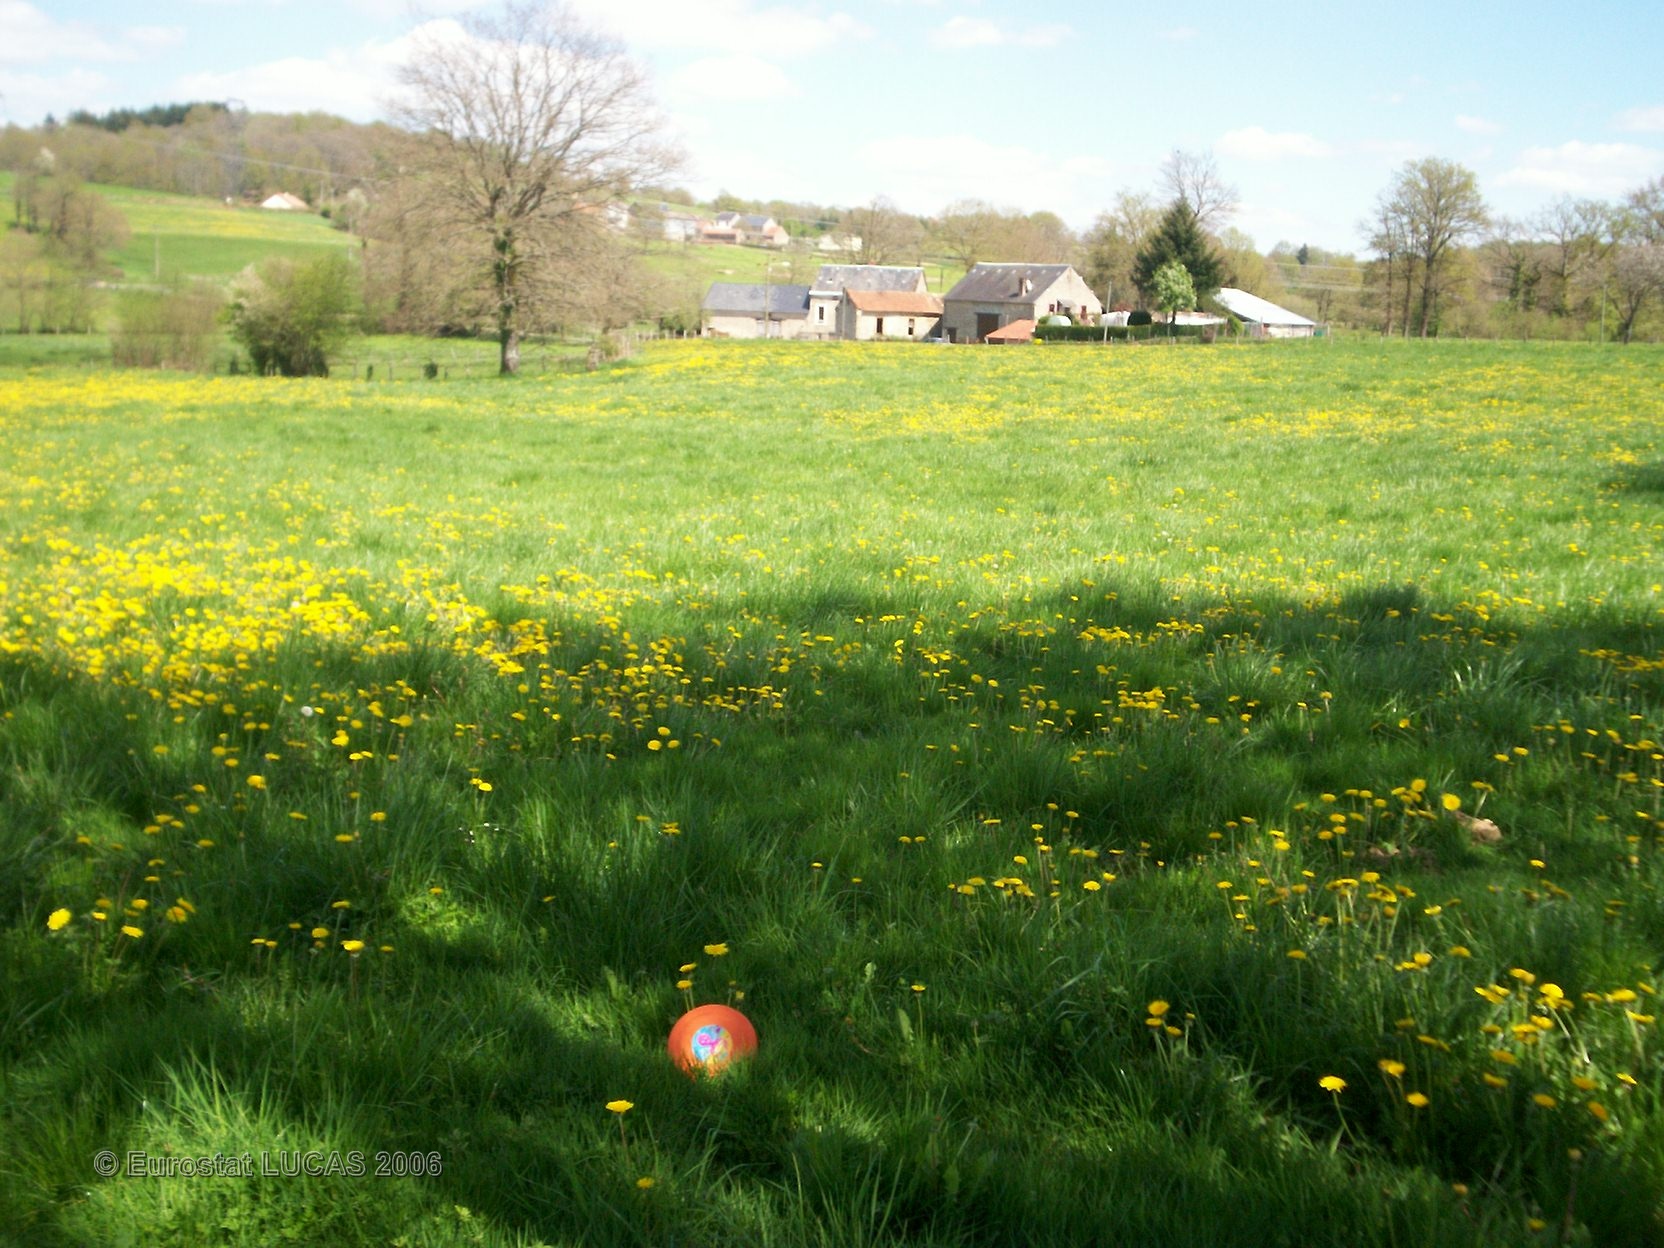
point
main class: Grassland
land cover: Grassland with sparse tree/shrub cover
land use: Agriculture (excluding fallow land and kitchen gardens)
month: April
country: FR
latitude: 46.2596
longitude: 1.6497
